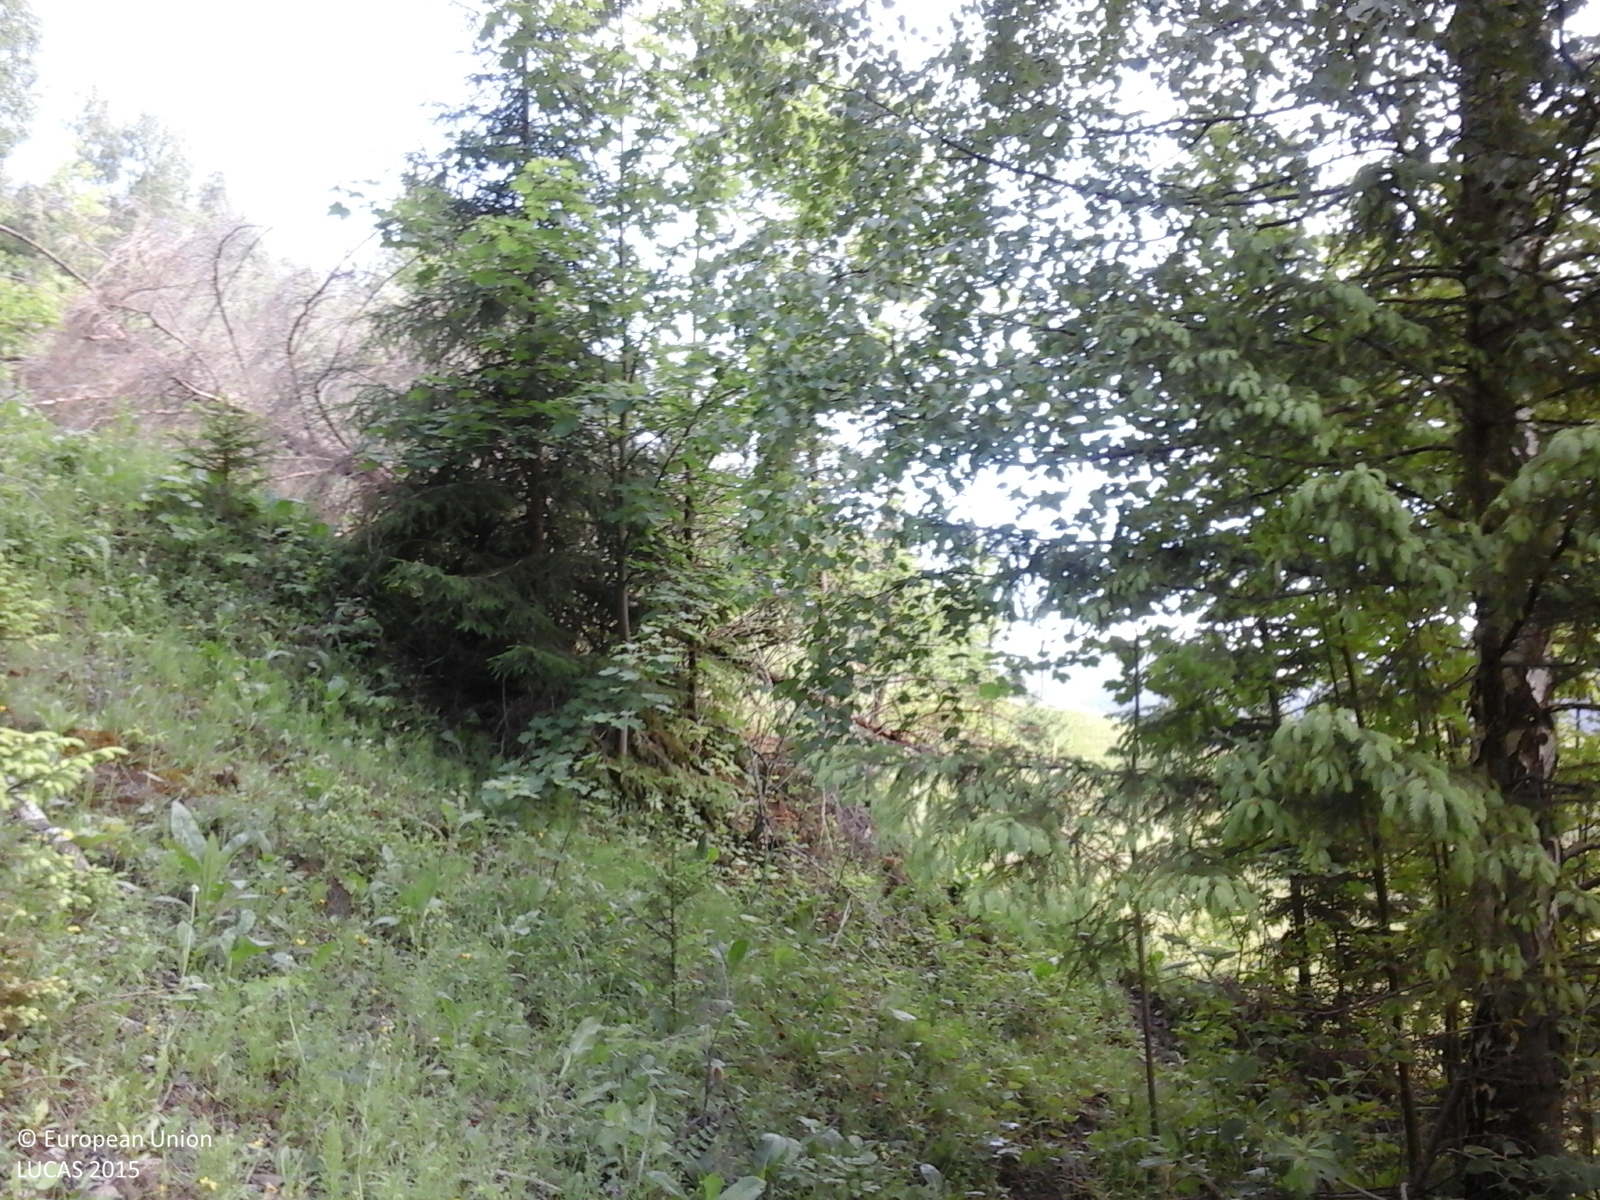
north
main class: Woodland
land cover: Broadleaved woodland
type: mountainous beech forest
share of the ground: > 75 %
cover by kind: broadleaved forest trees 80 %, coniferous forest trees 20 %
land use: Forestry
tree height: > 5 m
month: June
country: RO
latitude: 46.7900
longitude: 25.9871
